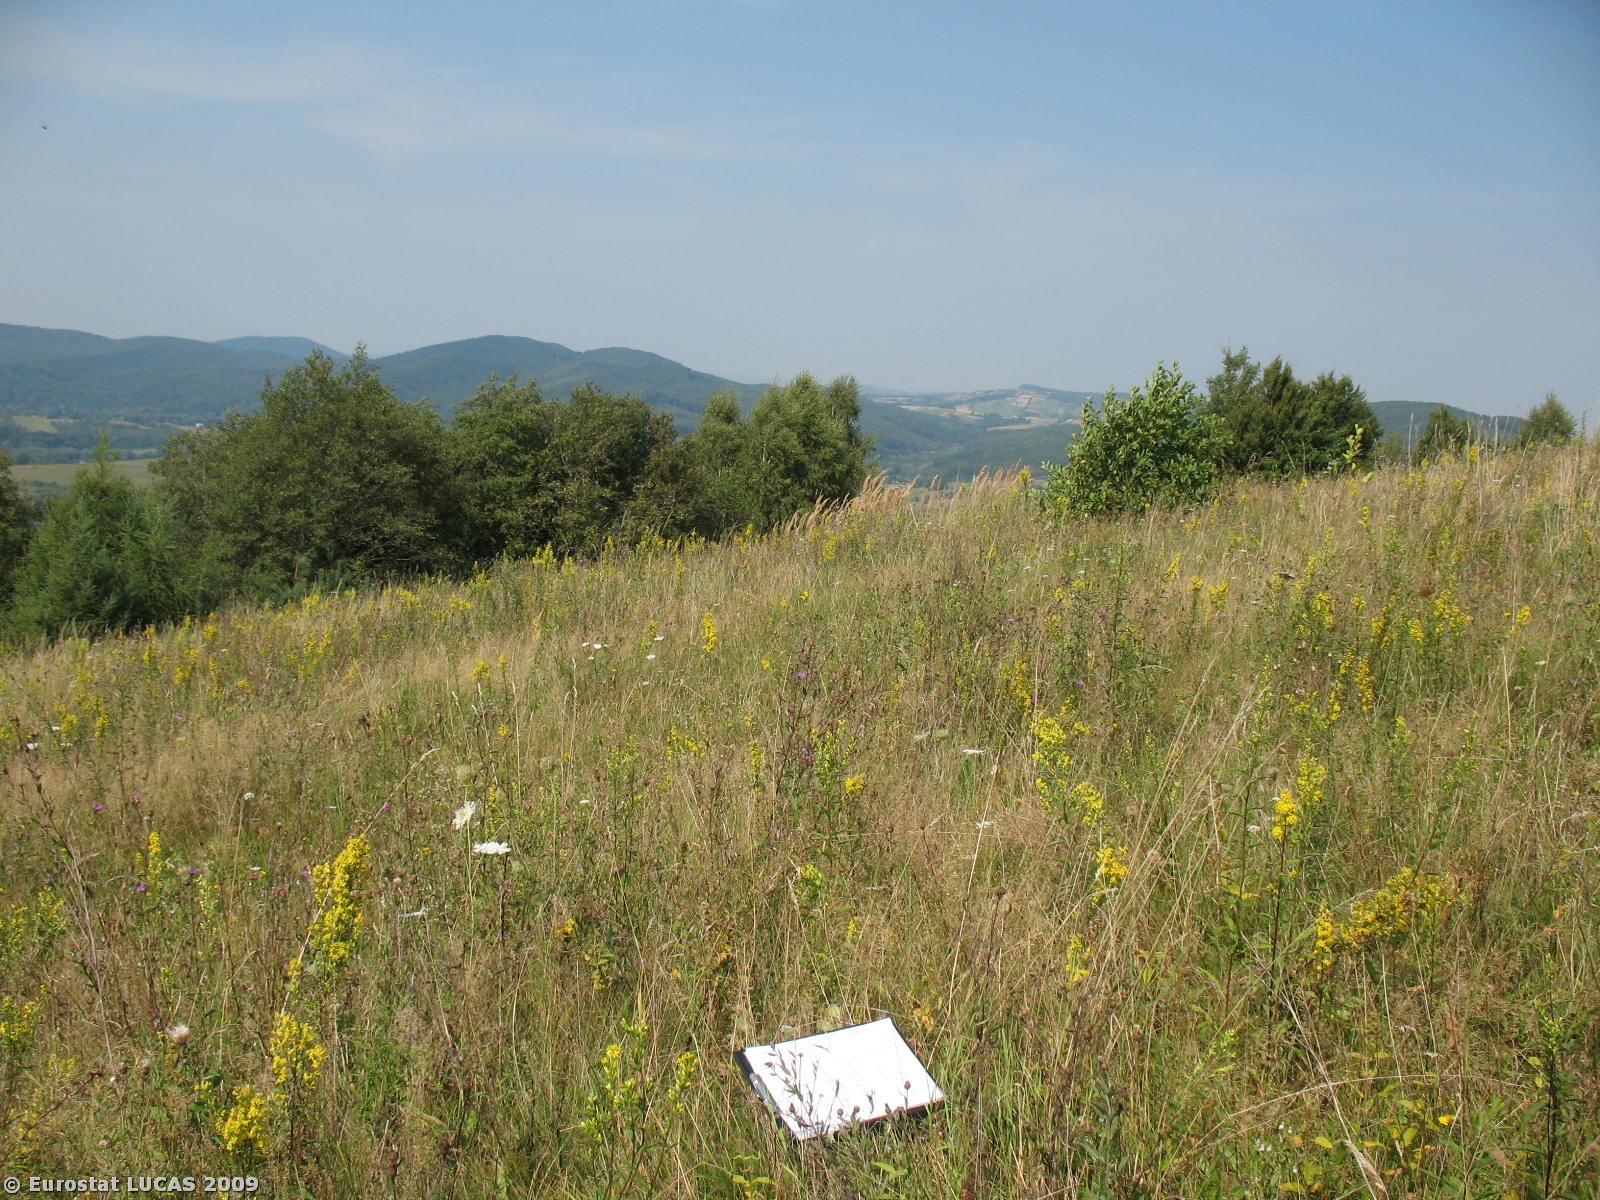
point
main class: Grassland
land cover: Spontaneously vegetated surfaces
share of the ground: > 75 %
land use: Fallow land
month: August
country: PL
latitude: 49.5936
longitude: 22.2487
